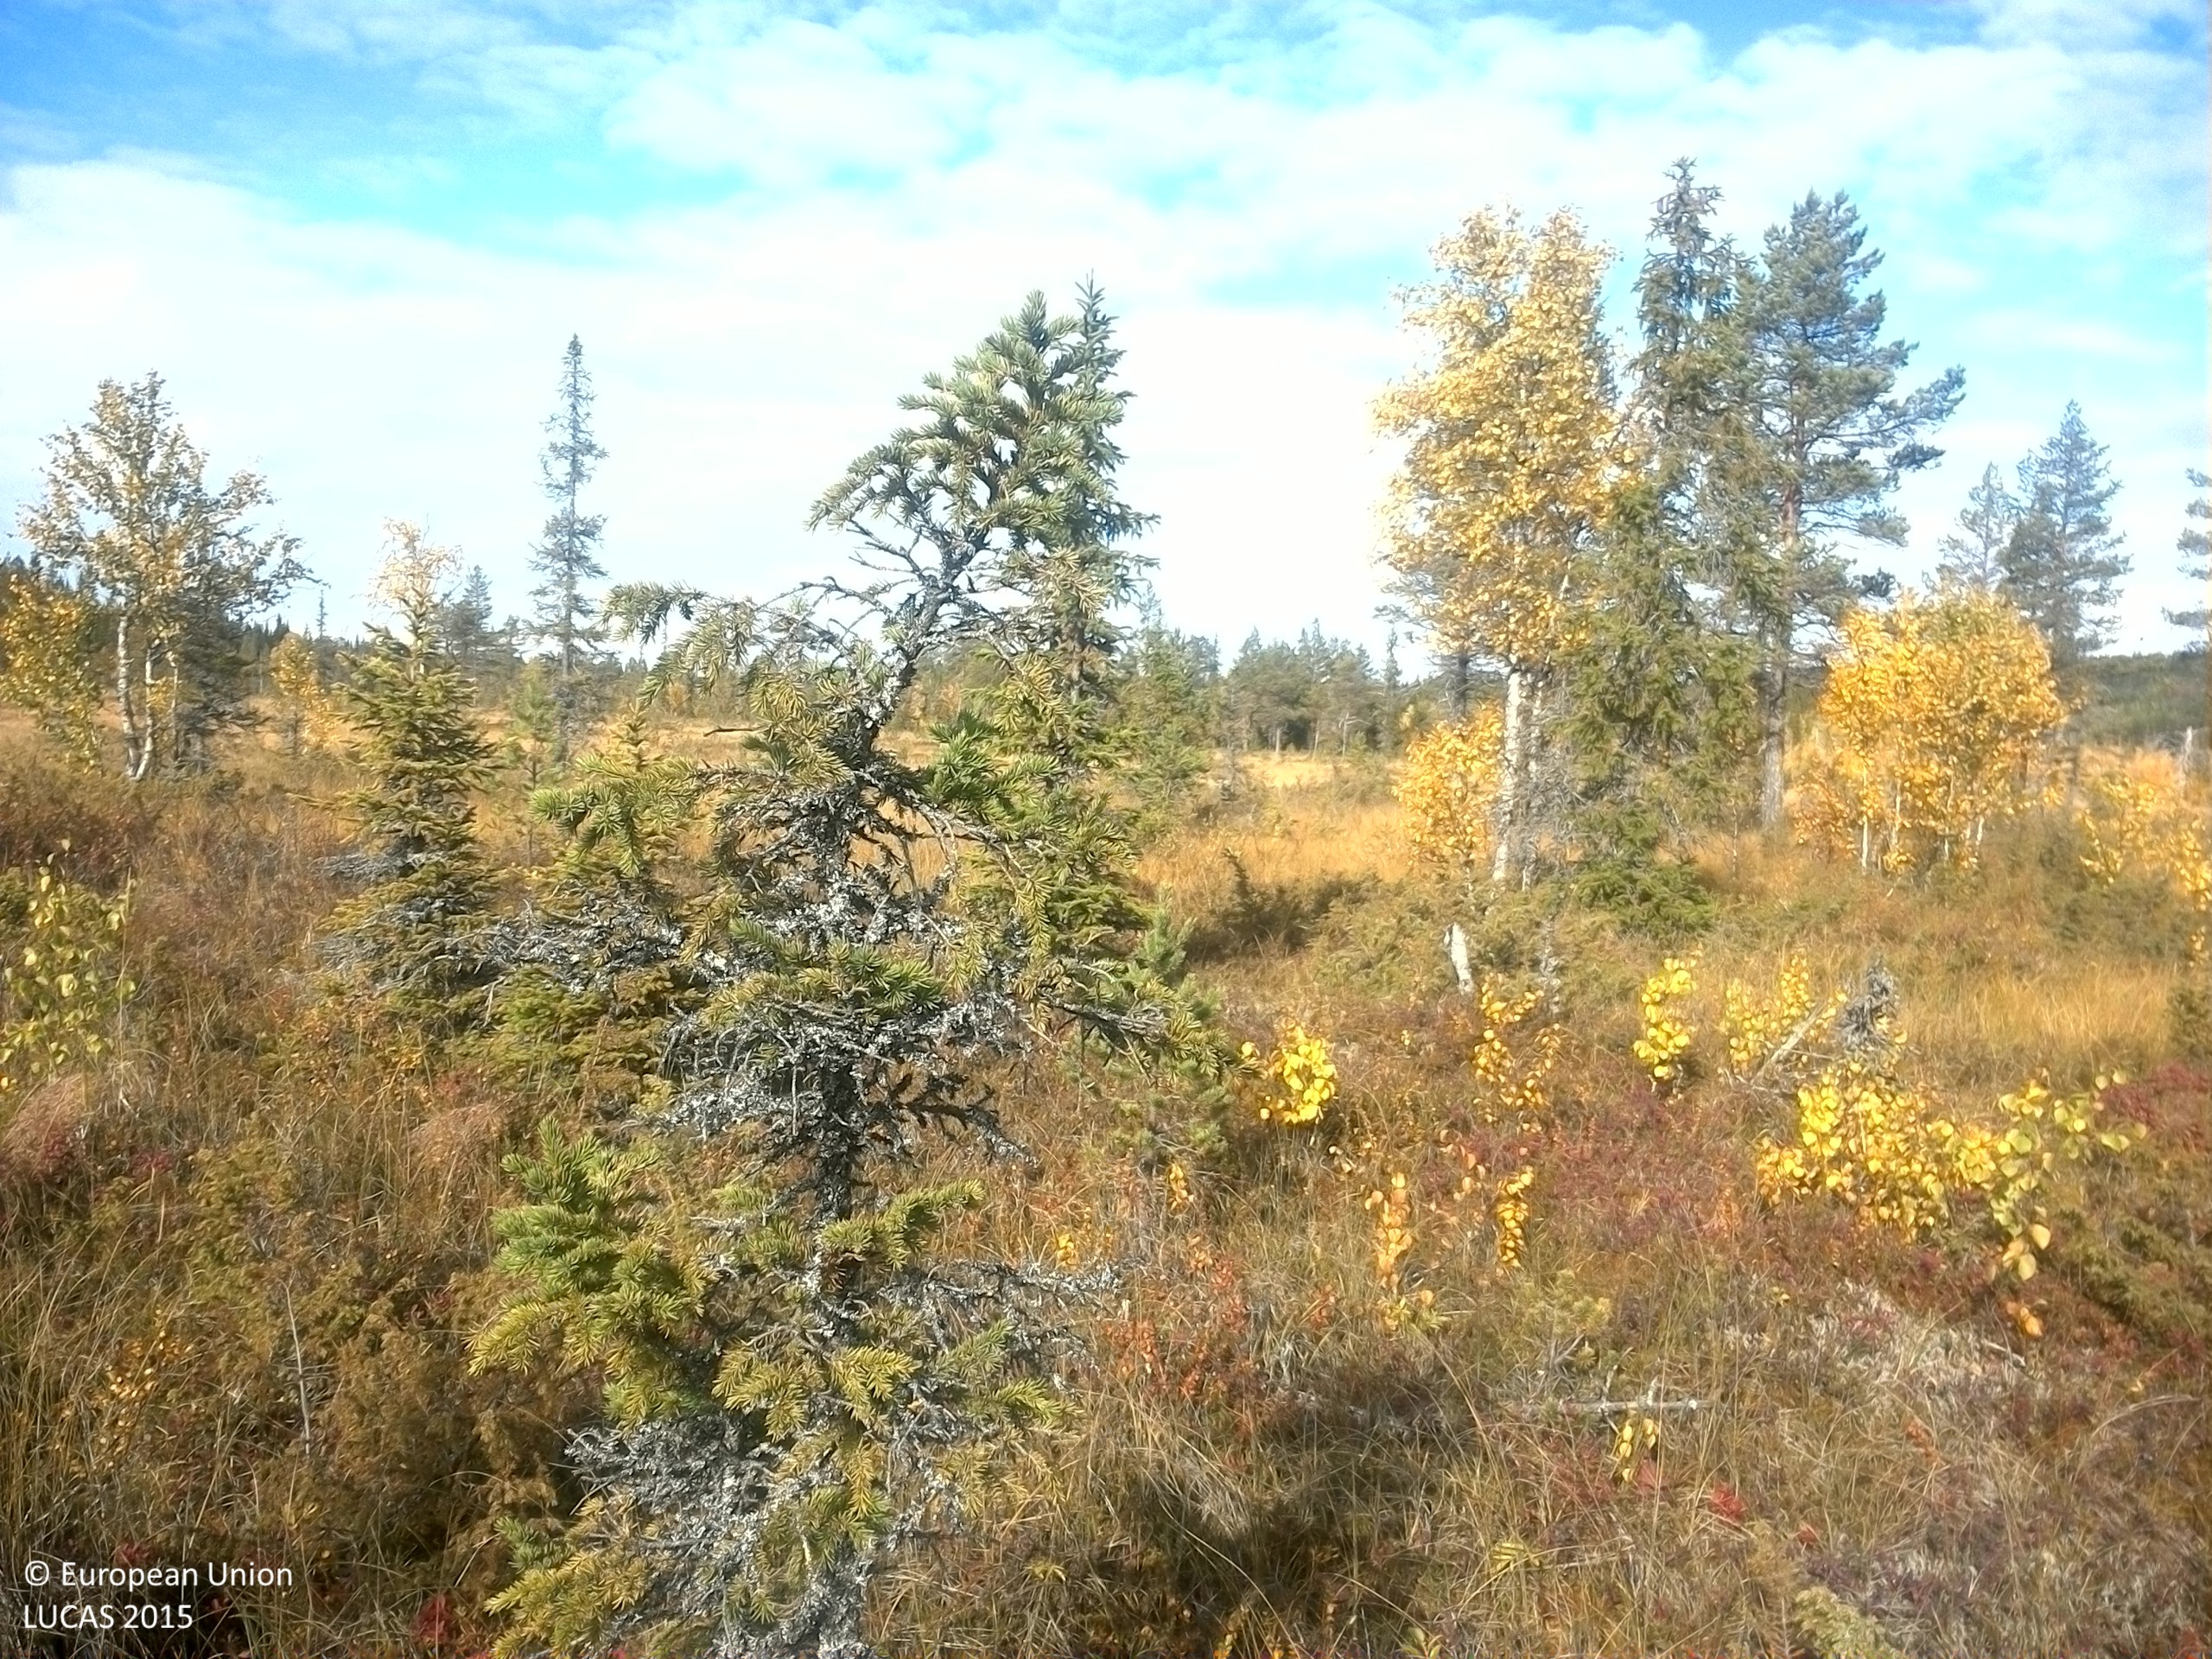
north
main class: Woodland
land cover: Spruce dominated mixed woodland
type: mire and swamp forests
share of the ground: 25 - 50 %
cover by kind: shrubs 50 %, lichens and mosses 20 %, coniferous forest trees 15 %, broadleaved forest trees 10 %, herbaceous plants 5 %
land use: Semi-natural and natural areas not in use
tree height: < 5 m
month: September
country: SE
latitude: 63.6011
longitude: 15.8805
